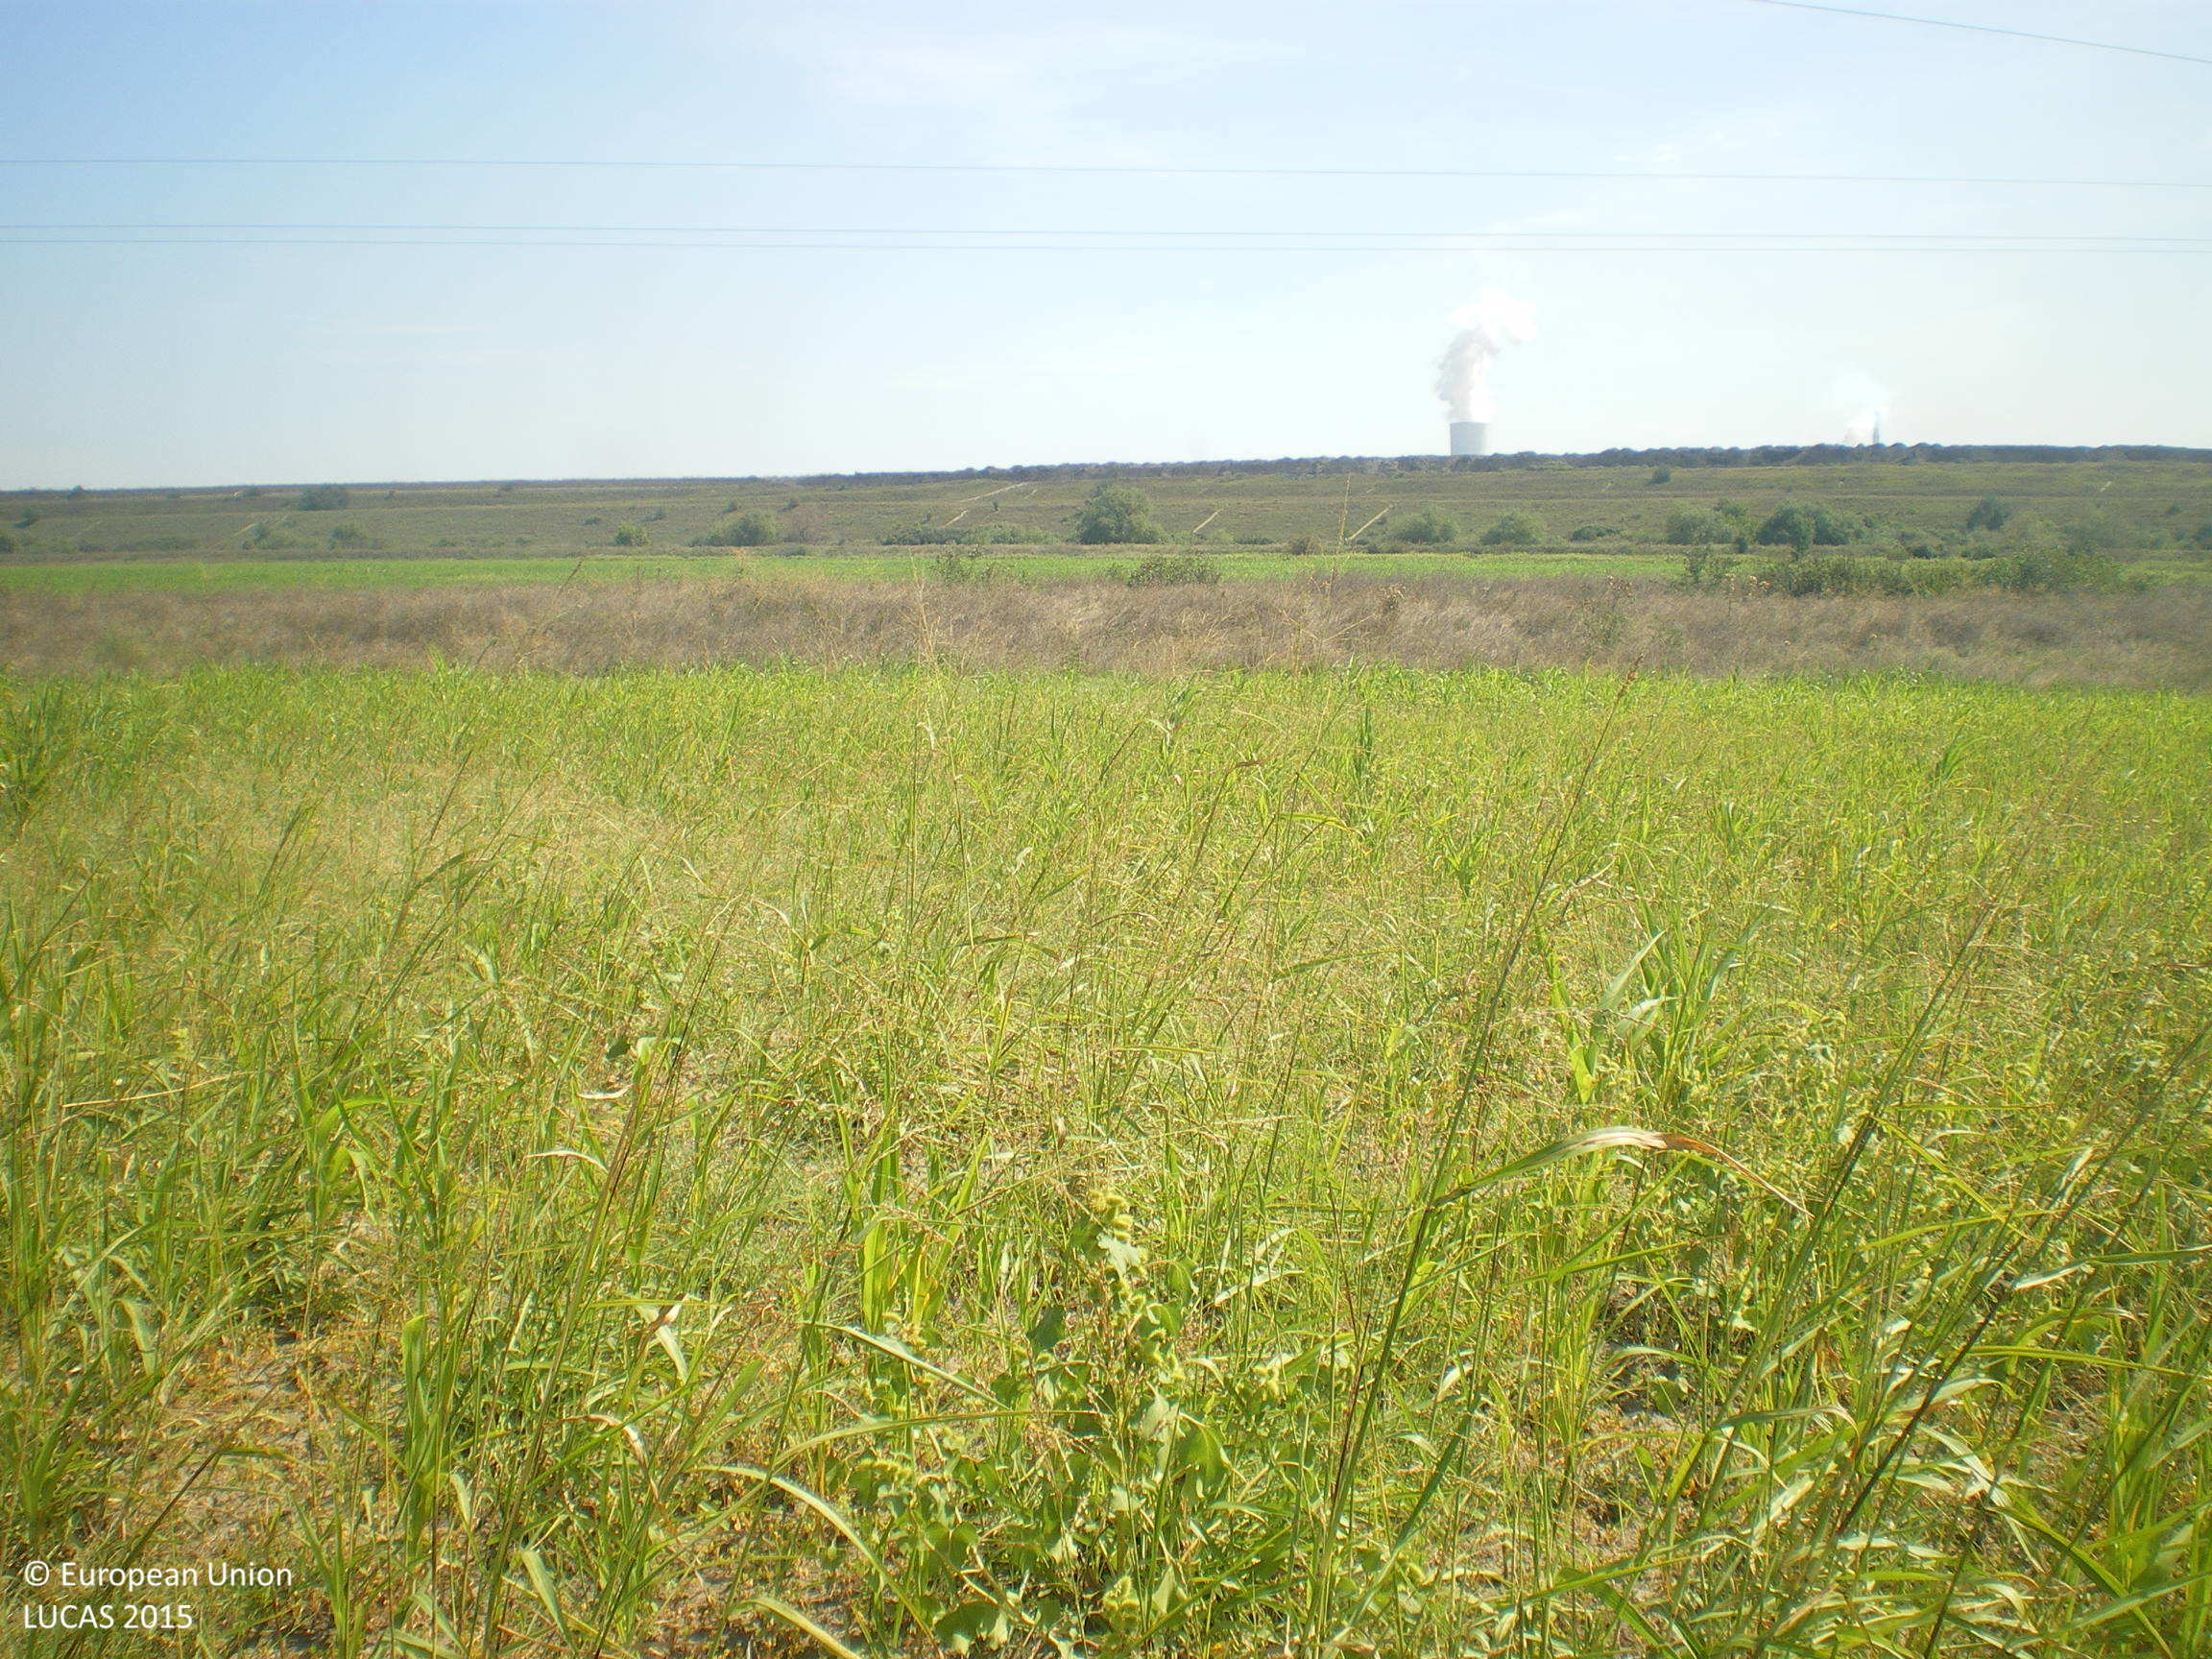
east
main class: Cropland
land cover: Maize
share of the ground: < 10 %
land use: Agriculture (excluding fallow land and kitchen gardens)
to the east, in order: Maize; Electric lines; Grassland without tree/shrub cover; Ditches and canals; Grassland without tree/shrub cover; Electric lines; Grassland without tree/shrub cover; Maize
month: September
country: BG
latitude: 42.1651
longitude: 25.8697
